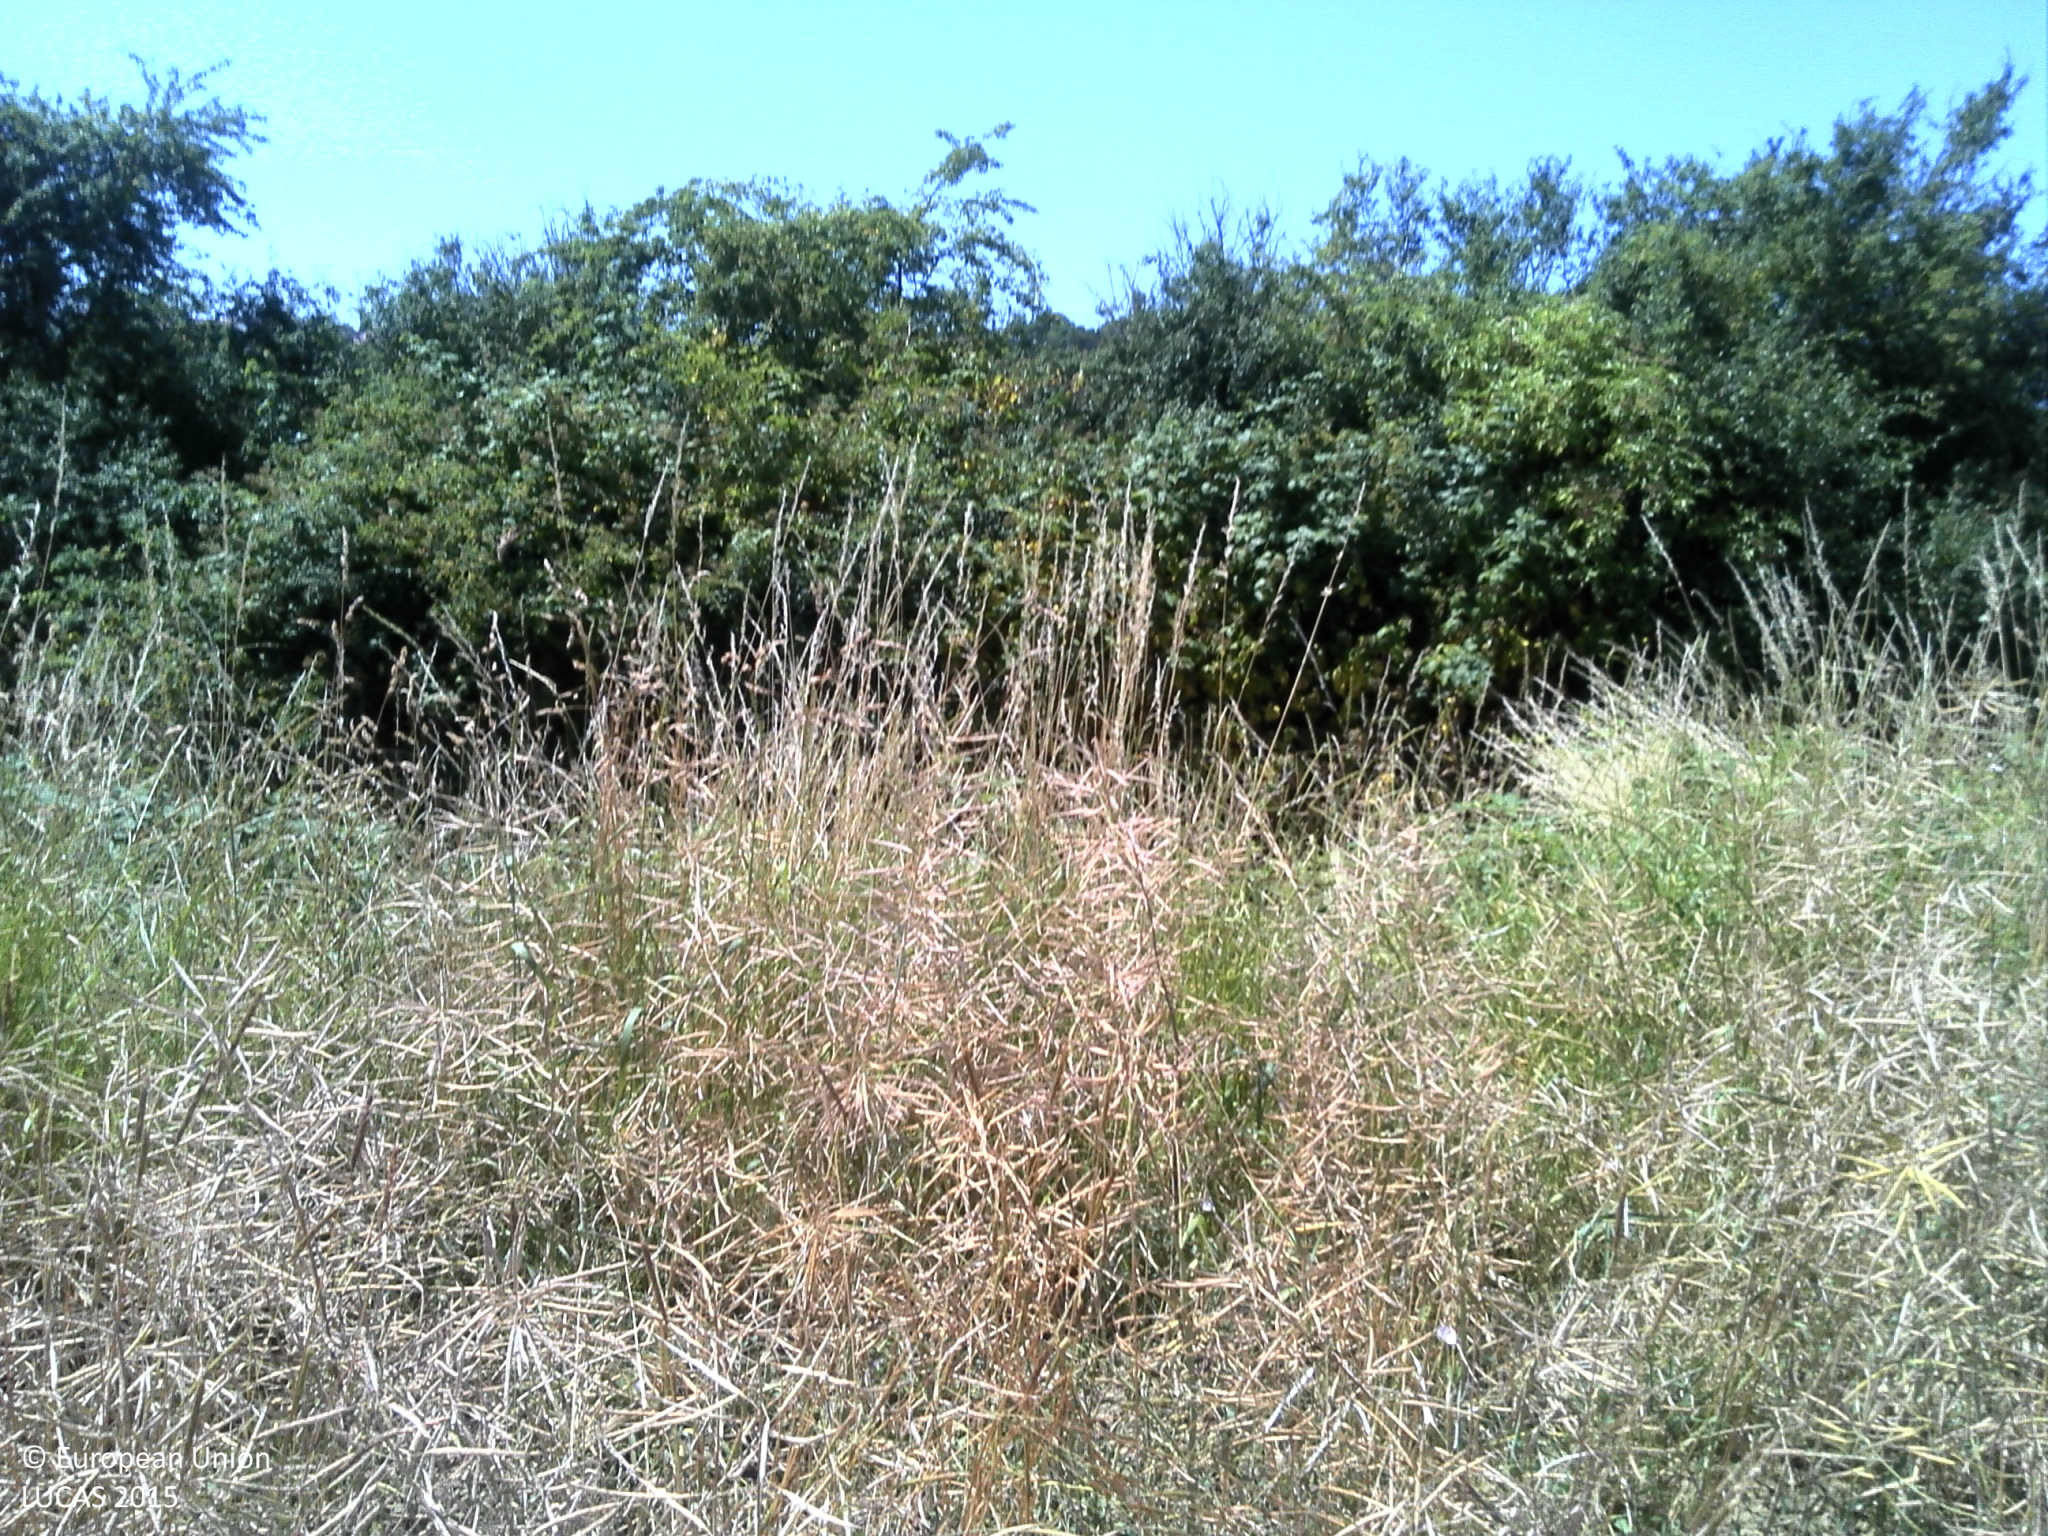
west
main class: Cropland
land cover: Rape and turnip rape
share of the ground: > 75 %
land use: Agriculture (excluding fallow land and kitchen gardens)
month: July
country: FR
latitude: 49.4370
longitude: 6.2073
